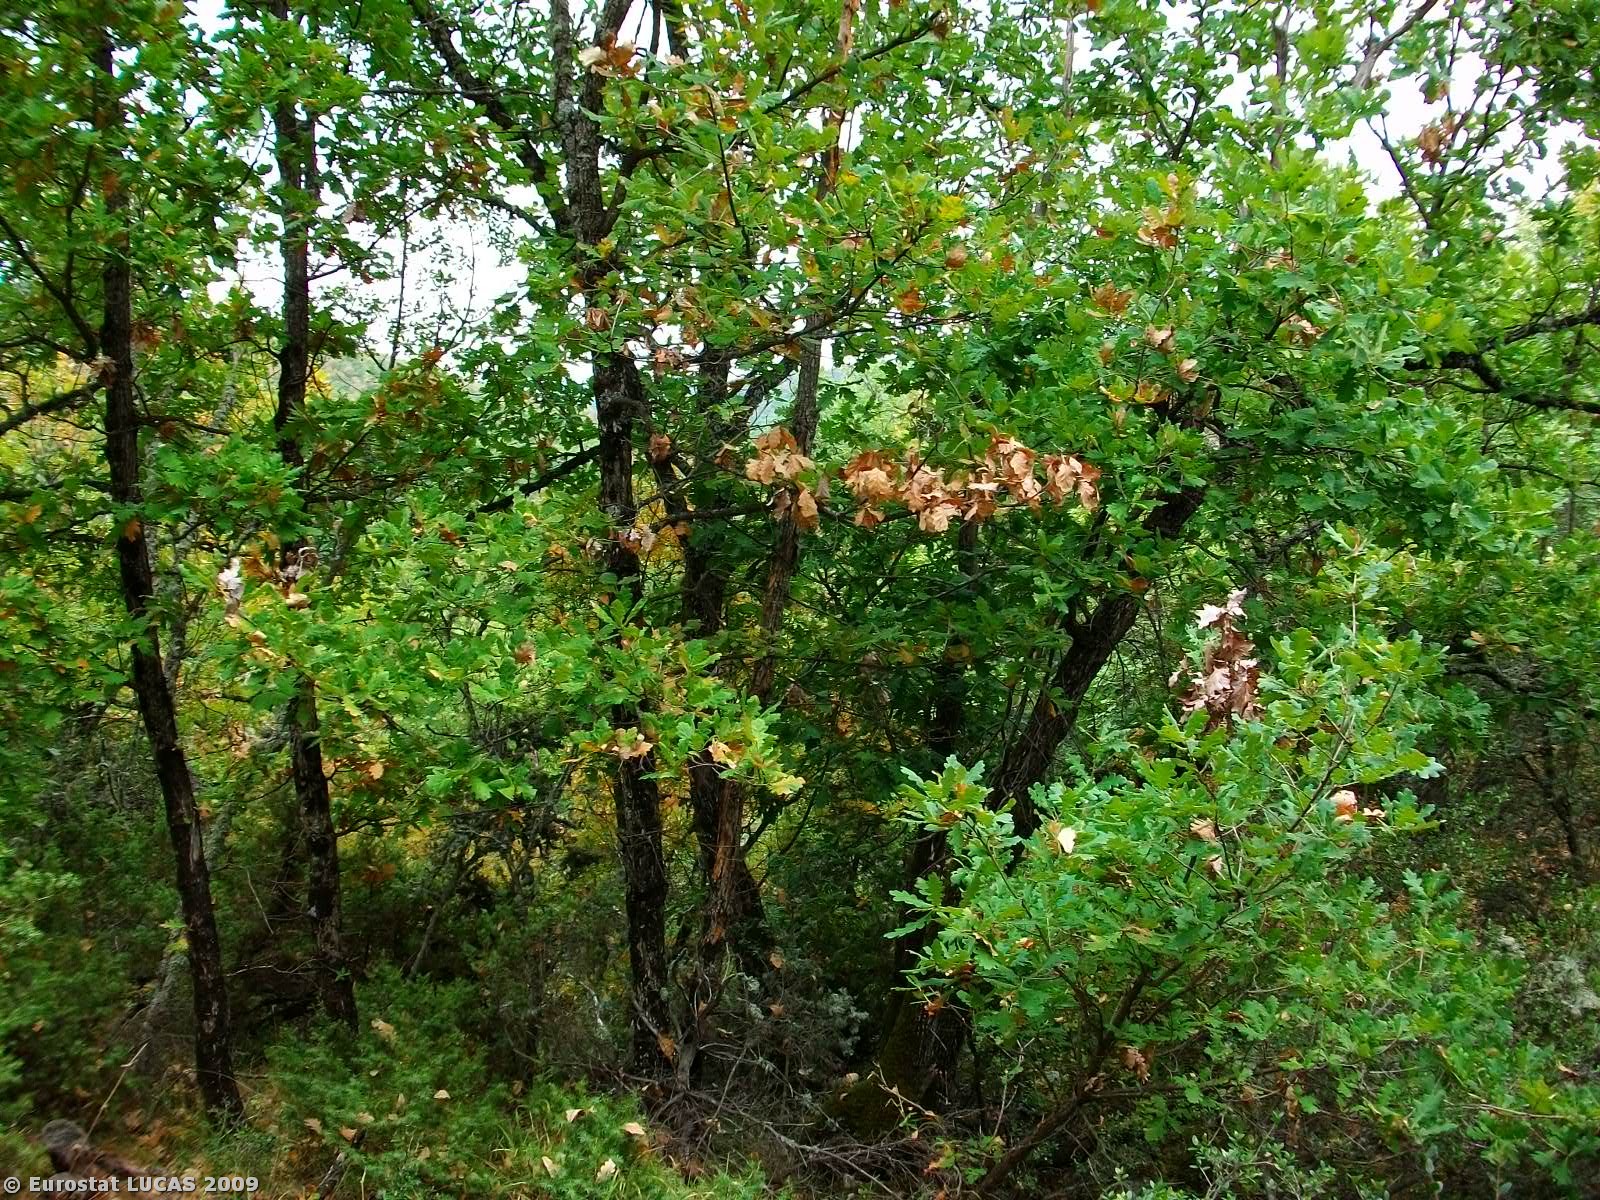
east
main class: Woodland
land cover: Broadleaved woodland
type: thermophilous deciduous forest
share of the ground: > 75 %
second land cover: Grassland with sparse tree/shrub cover
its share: 50 - 75 %
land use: Forestry
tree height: > 5 m
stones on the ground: 10 - 25 %
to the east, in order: Broadleaved woodland; Grassland with sparse tree/shrub cover; Tracks; Broadleaved woodland; Tracks; Shrubland with sparse tree cover
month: September
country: GR
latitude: 41.2691
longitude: 26.2935
